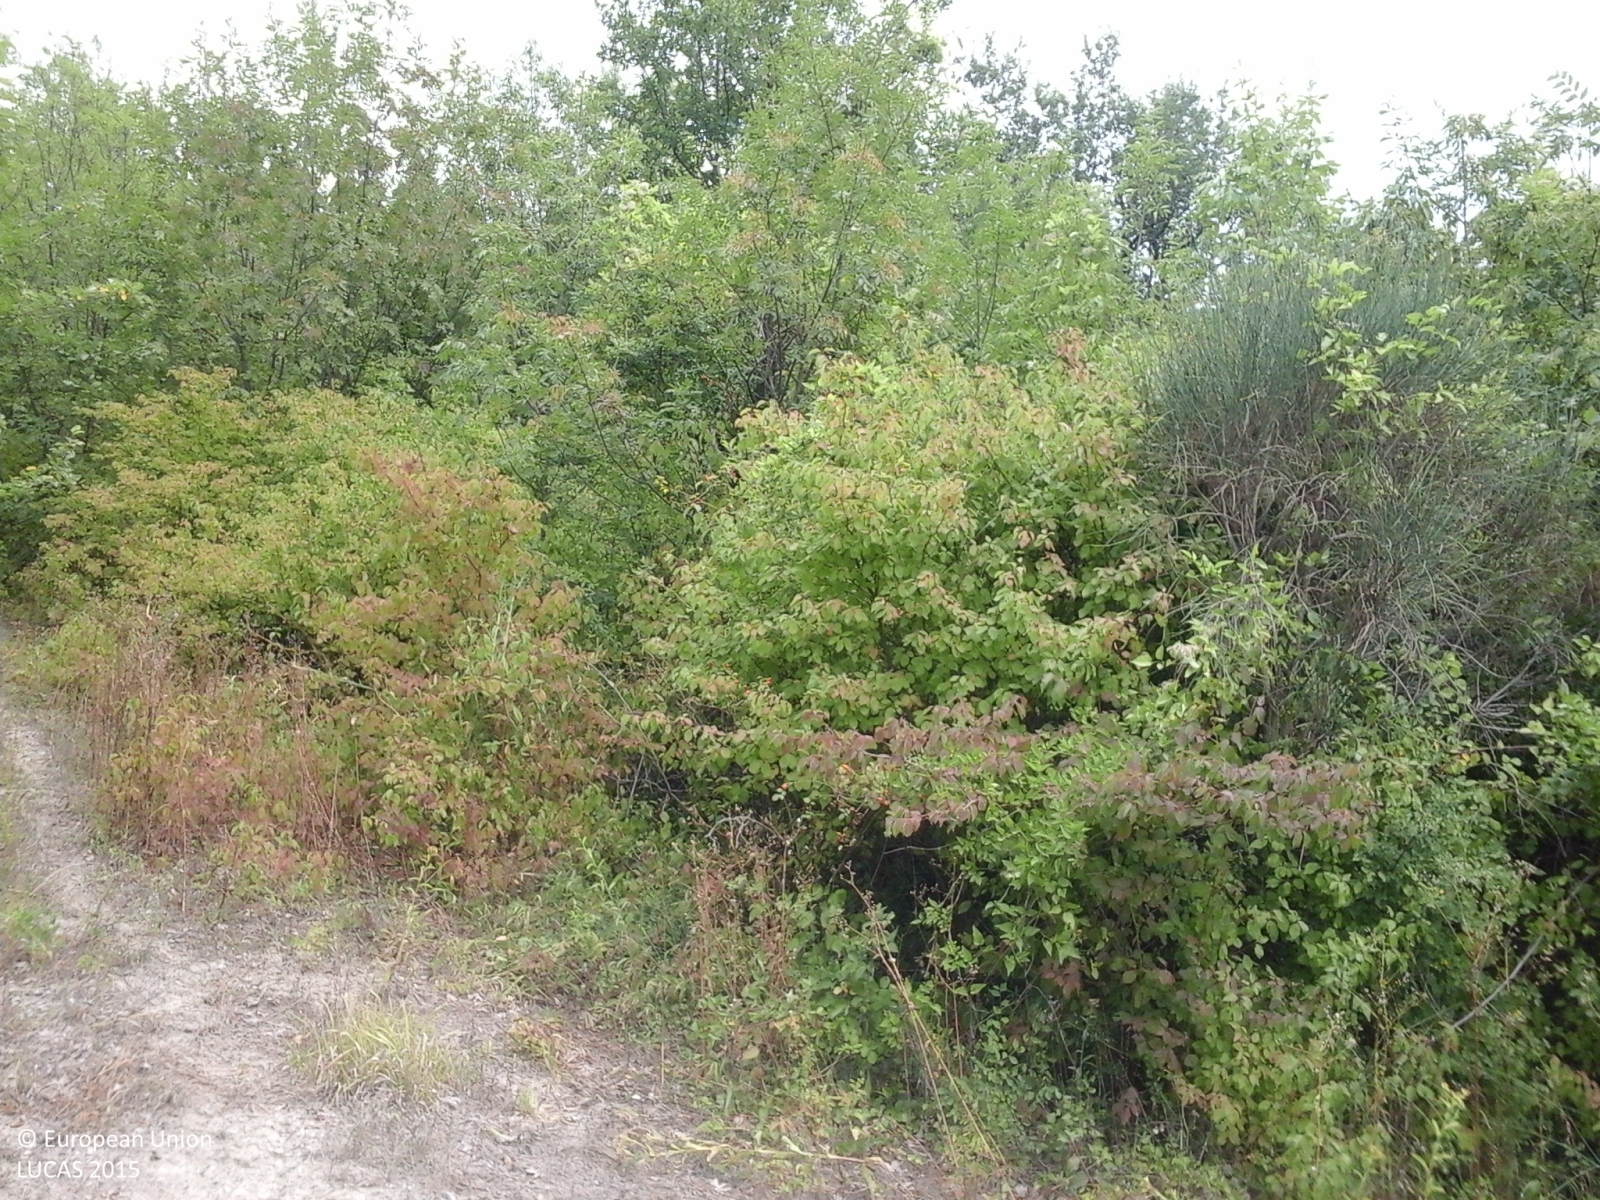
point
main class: Woodland
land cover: Broadleaved woodland
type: mesophytic deciduous forest
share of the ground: > 75 %
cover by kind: broadleaved forest trees 80 %, shrubs 15 %, herbaceous plants 5 %
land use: Forestry
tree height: > 5 m
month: August
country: IT
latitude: 44.9785
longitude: 9.1773
